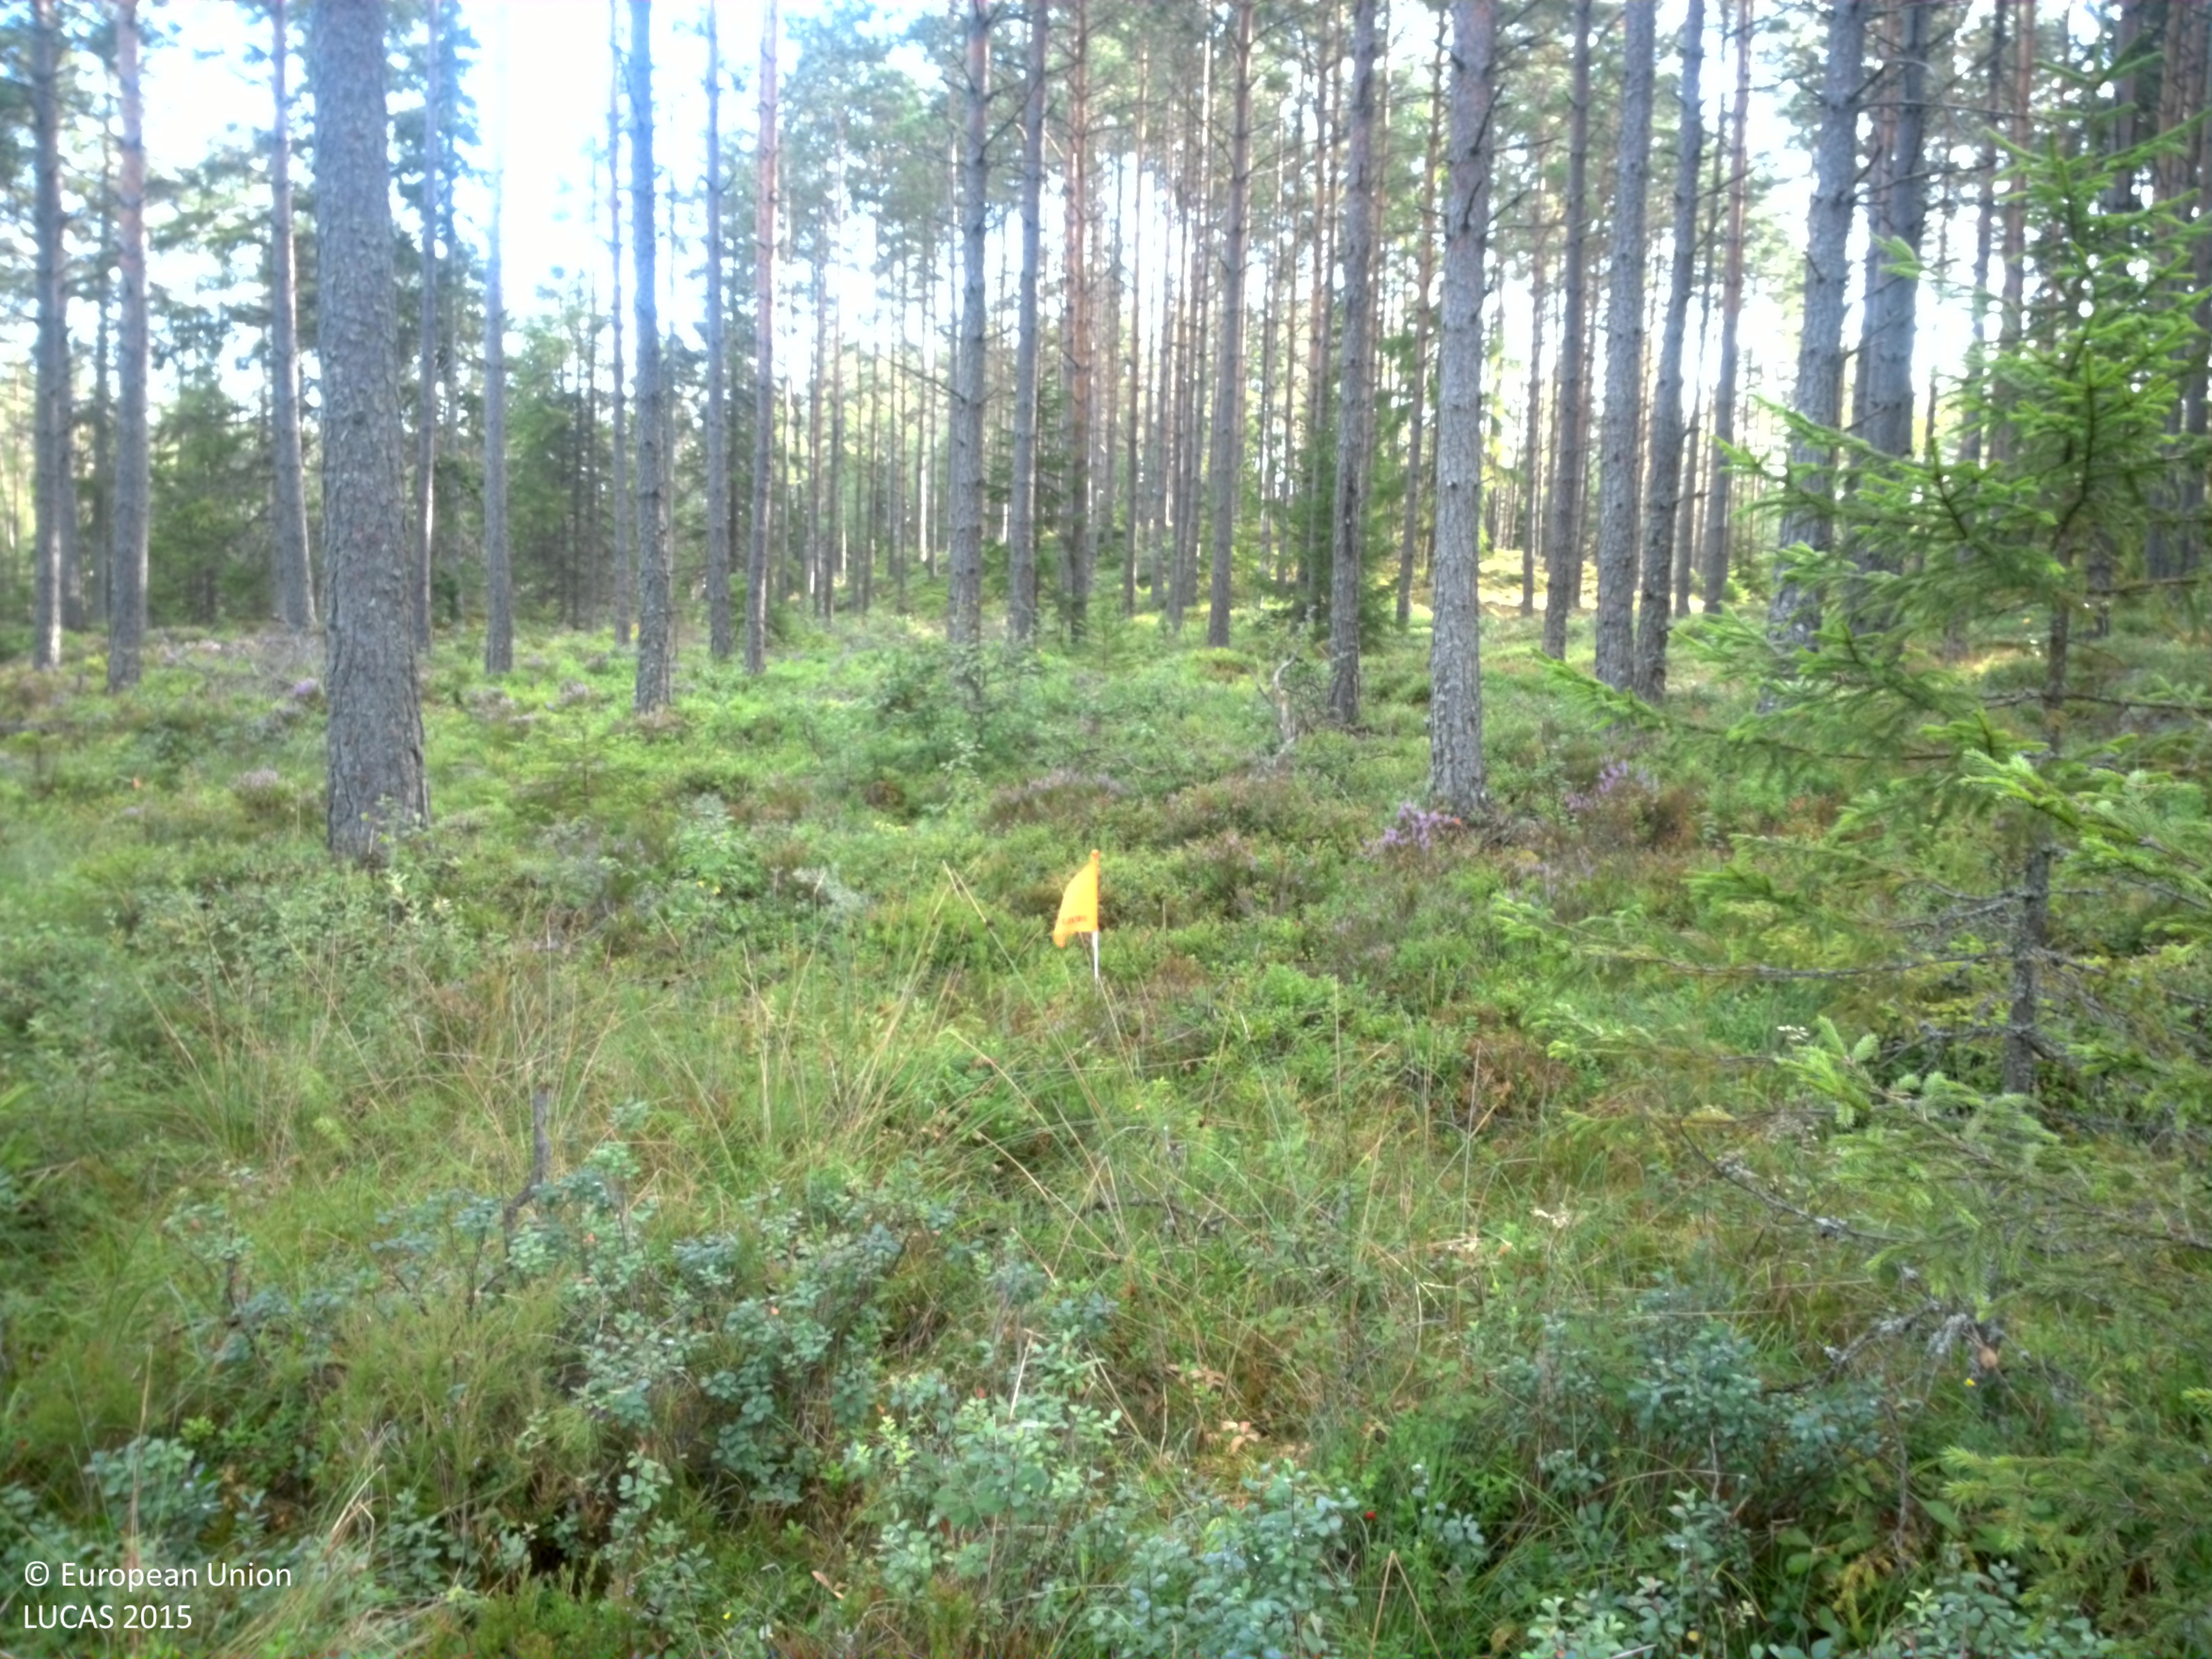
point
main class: Woodland
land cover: Pine dominated coniferous woodland
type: boreal forest
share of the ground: 25 - 50 %
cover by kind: coniferous forest trees 35 %, shrubs 30 %, lichens and mosses 30 %, broadleaved forest trees 5 %
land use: Forestry
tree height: > 5 m
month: August
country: SE
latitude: 57.7834
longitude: 13.9472
